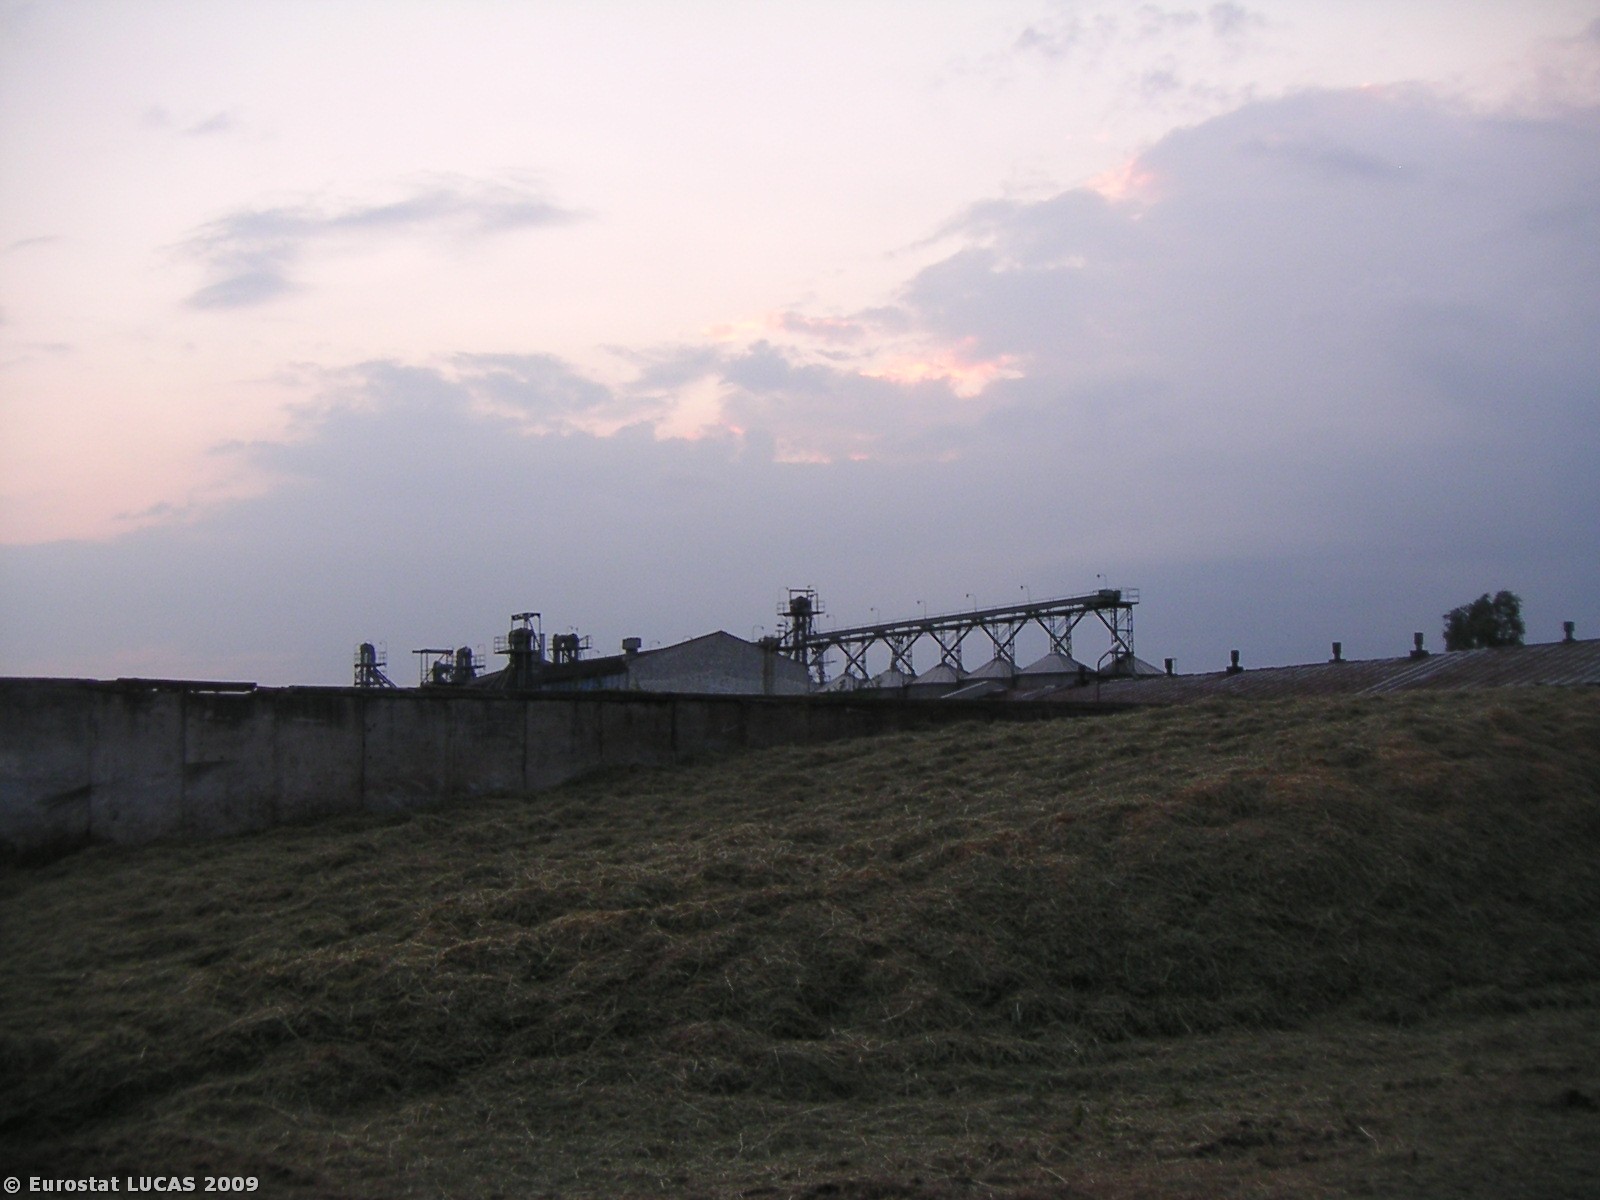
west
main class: Cropland
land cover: Maize
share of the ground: > 75 %
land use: Agriculture (excluding fallow land and kitchen gardens)
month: July
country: PL
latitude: 50.6105
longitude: 19.8239
